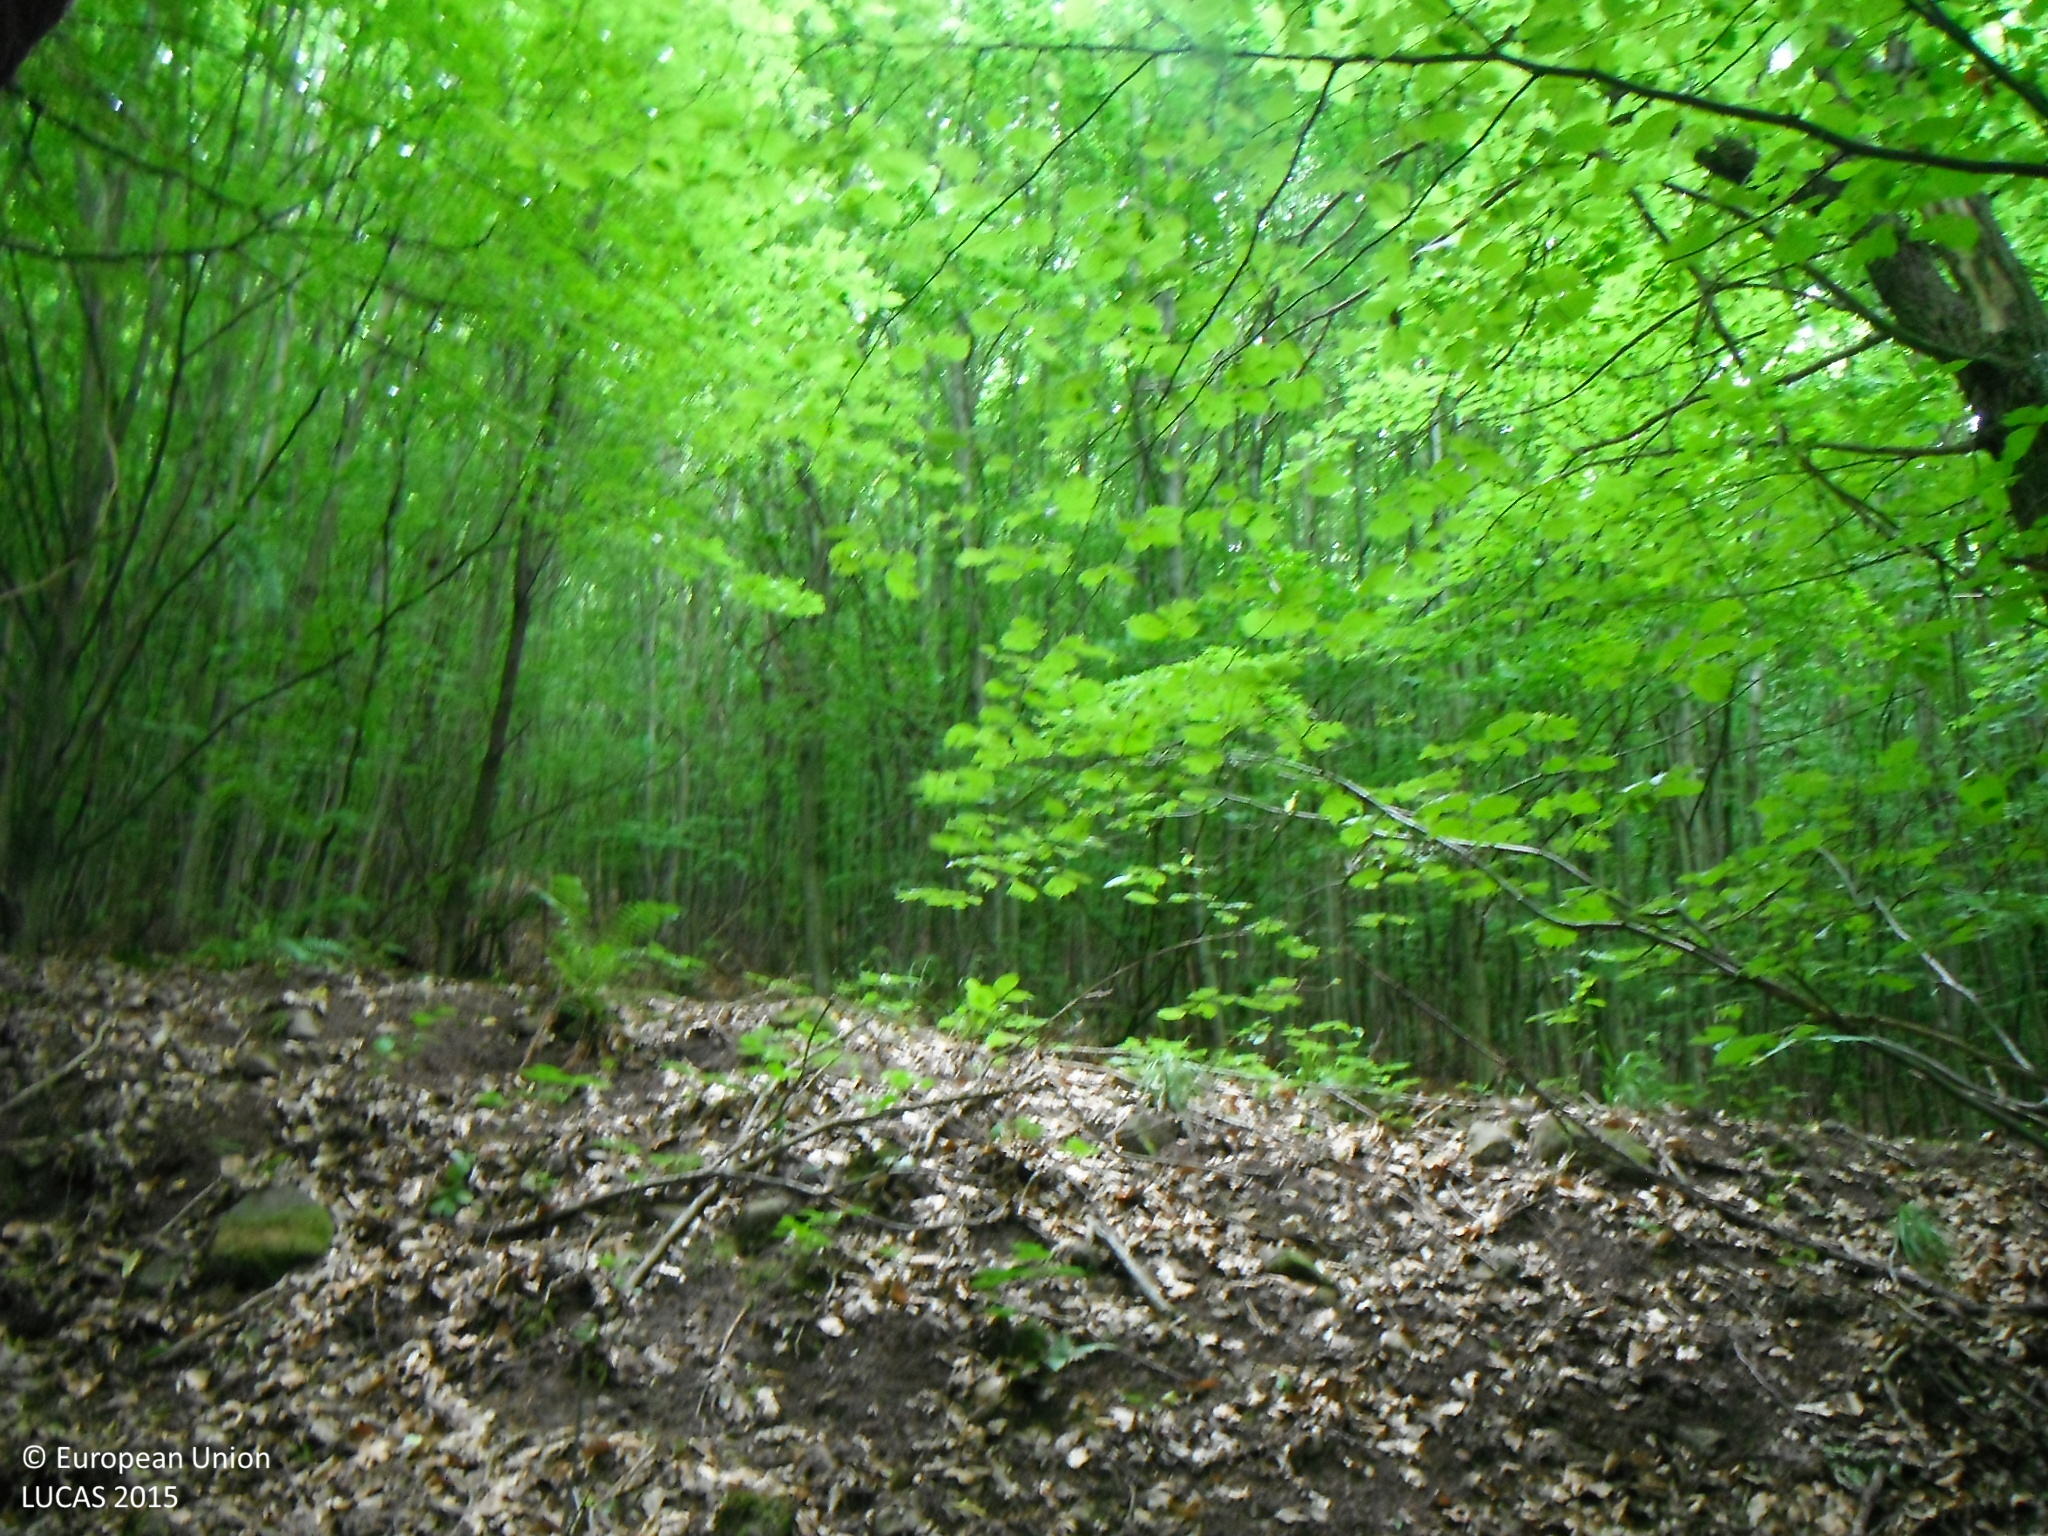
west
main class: Woodland
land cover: Broadleaved woodland
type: beech forest
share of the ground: > 75 %
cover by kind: broadleaved forest trees 100 %
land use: Forestry
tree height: > 5 m
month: June
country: SK
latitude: 48.2685
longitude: 19.2507
